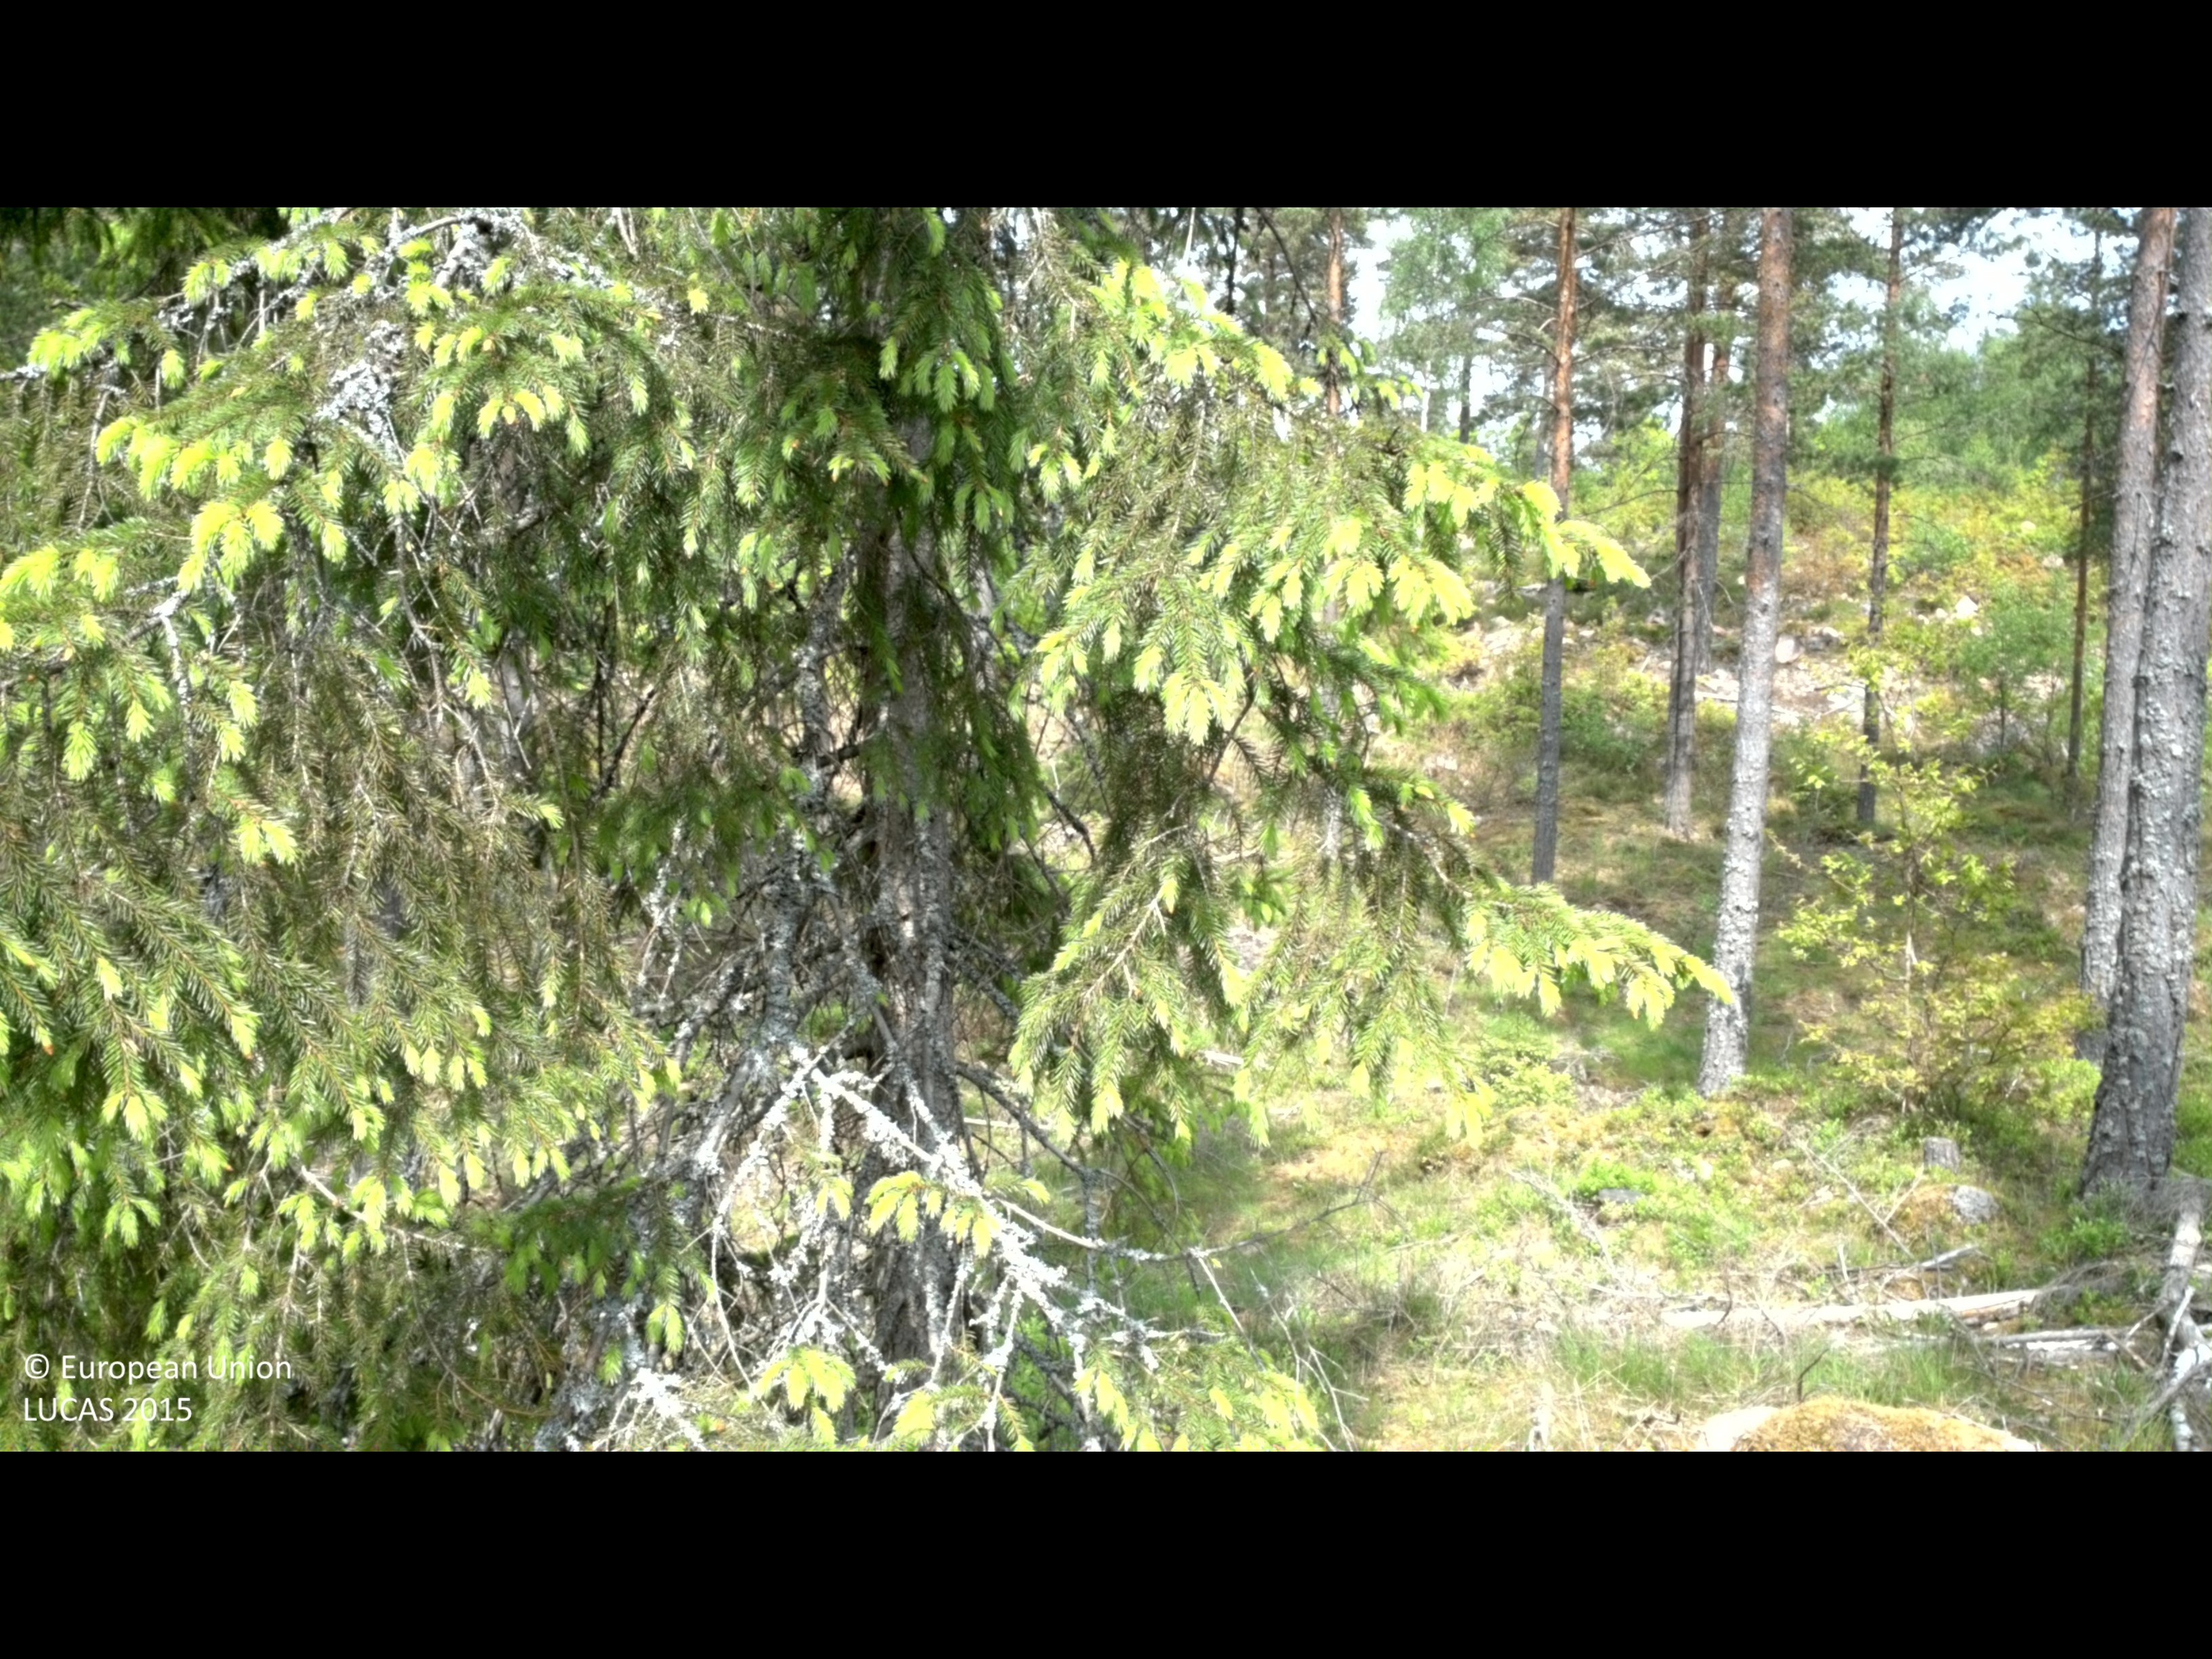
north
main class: Woodland
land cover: Pine dominated coniferous woodland
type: boreal forest
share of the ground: 25 - 50 %
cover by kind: coniferous forest trees 40 %, lichens and mosses 30 %, shrubs 25 %, broadleaved forest trees 5 %
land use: Forestry
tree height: > 5 m
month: May
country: SE
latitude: 57.3567
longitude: 16.5322
